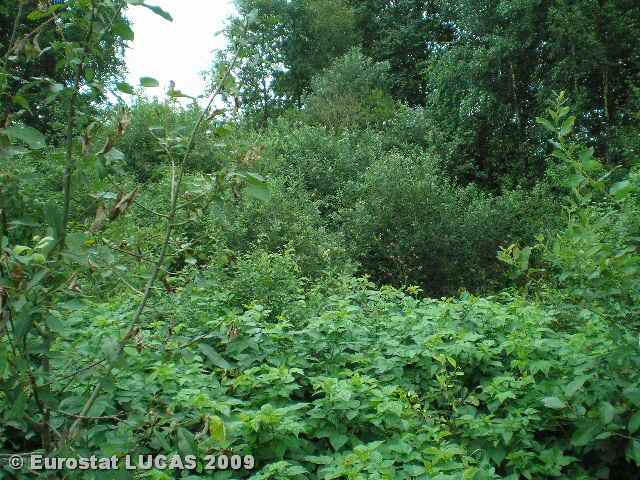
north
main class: Woodland
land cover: Broadleaved woodland
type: hemiboreal forest and nemoral coniferous forest and mixed broadleaved-coniferous forest
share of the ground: > 75 %
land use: Forestry
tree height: > 5 m
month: July
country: LT
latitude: 54.9839
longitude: 25.3264
